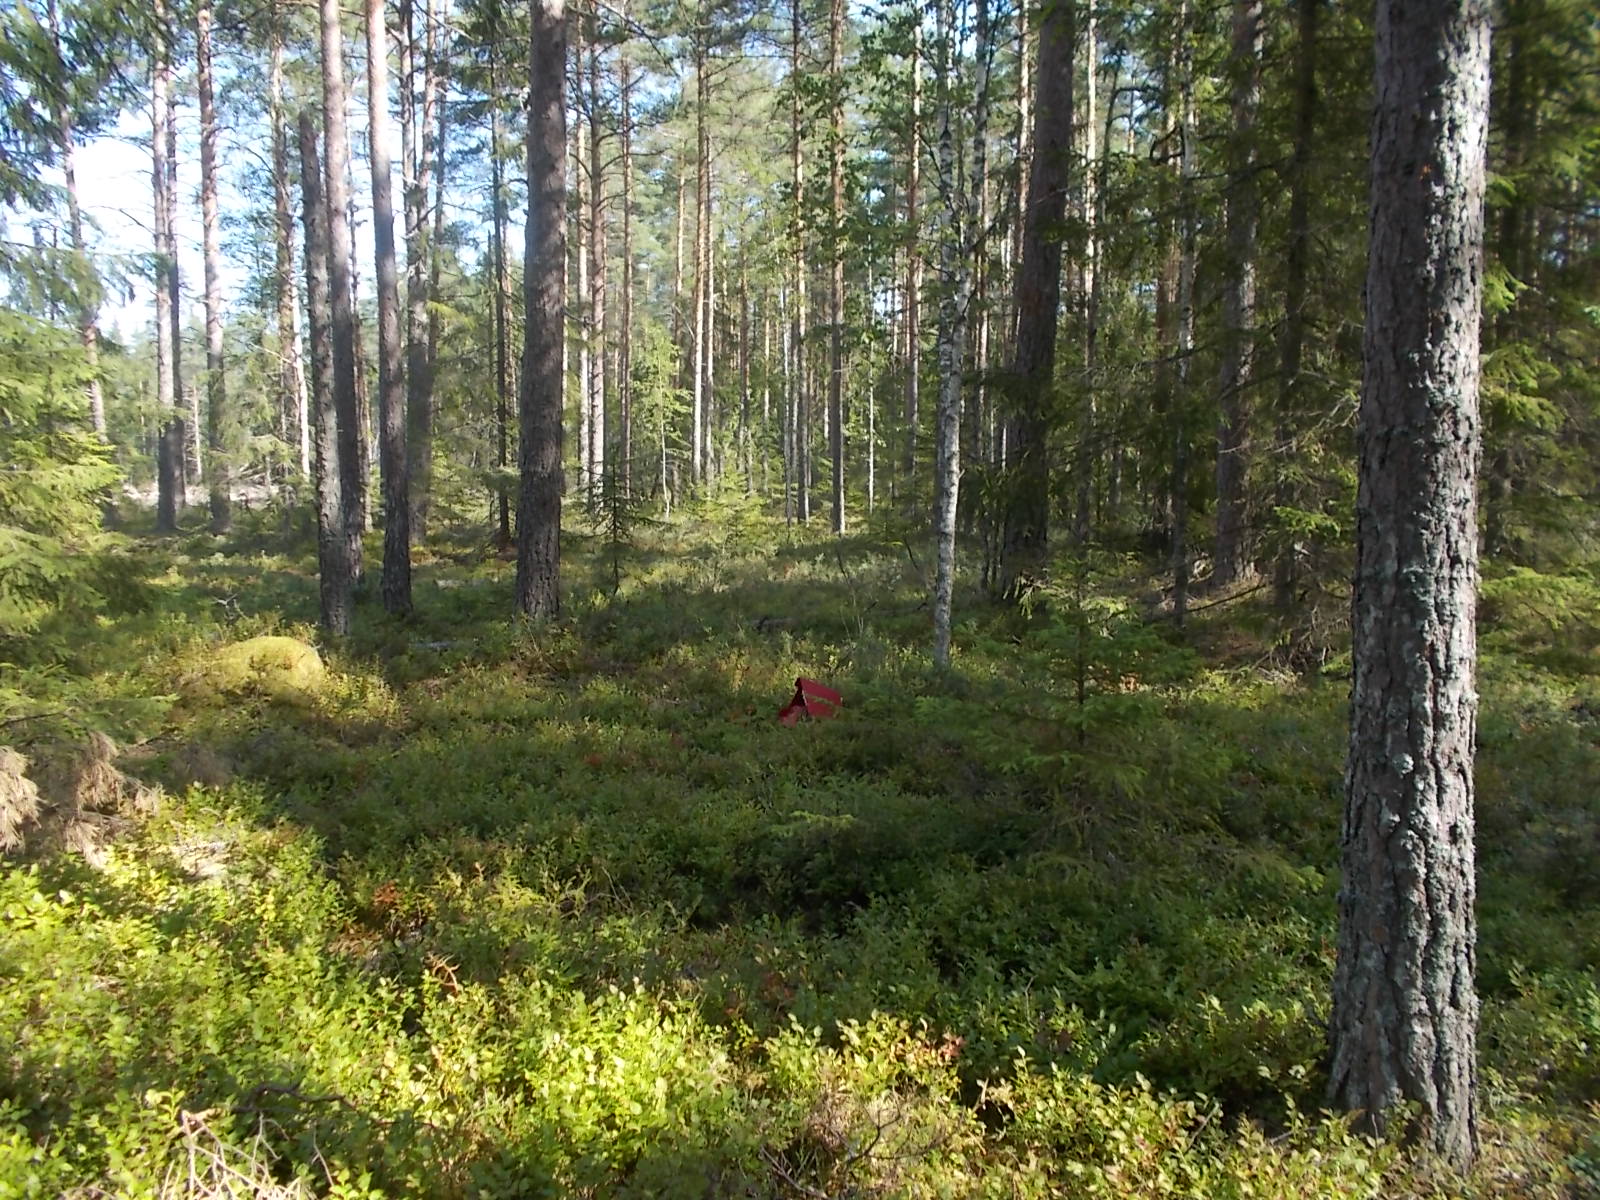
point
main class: Woodland
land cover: Other coniferous woodland
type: hemiboreal forest and nemoral coniferous forest and mixed broadleaved-coniferous forest
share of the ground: 50 - 75 %
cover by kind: coniferous forest trees 60 %, broadleaved forest trees 10 %, shrubs 10 %, herbaceous plants 10 %, lichens and mosses 10 %
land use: Forestry
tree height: > 5 m
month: August
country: LV
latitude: 57.0631
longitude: 21.9693
